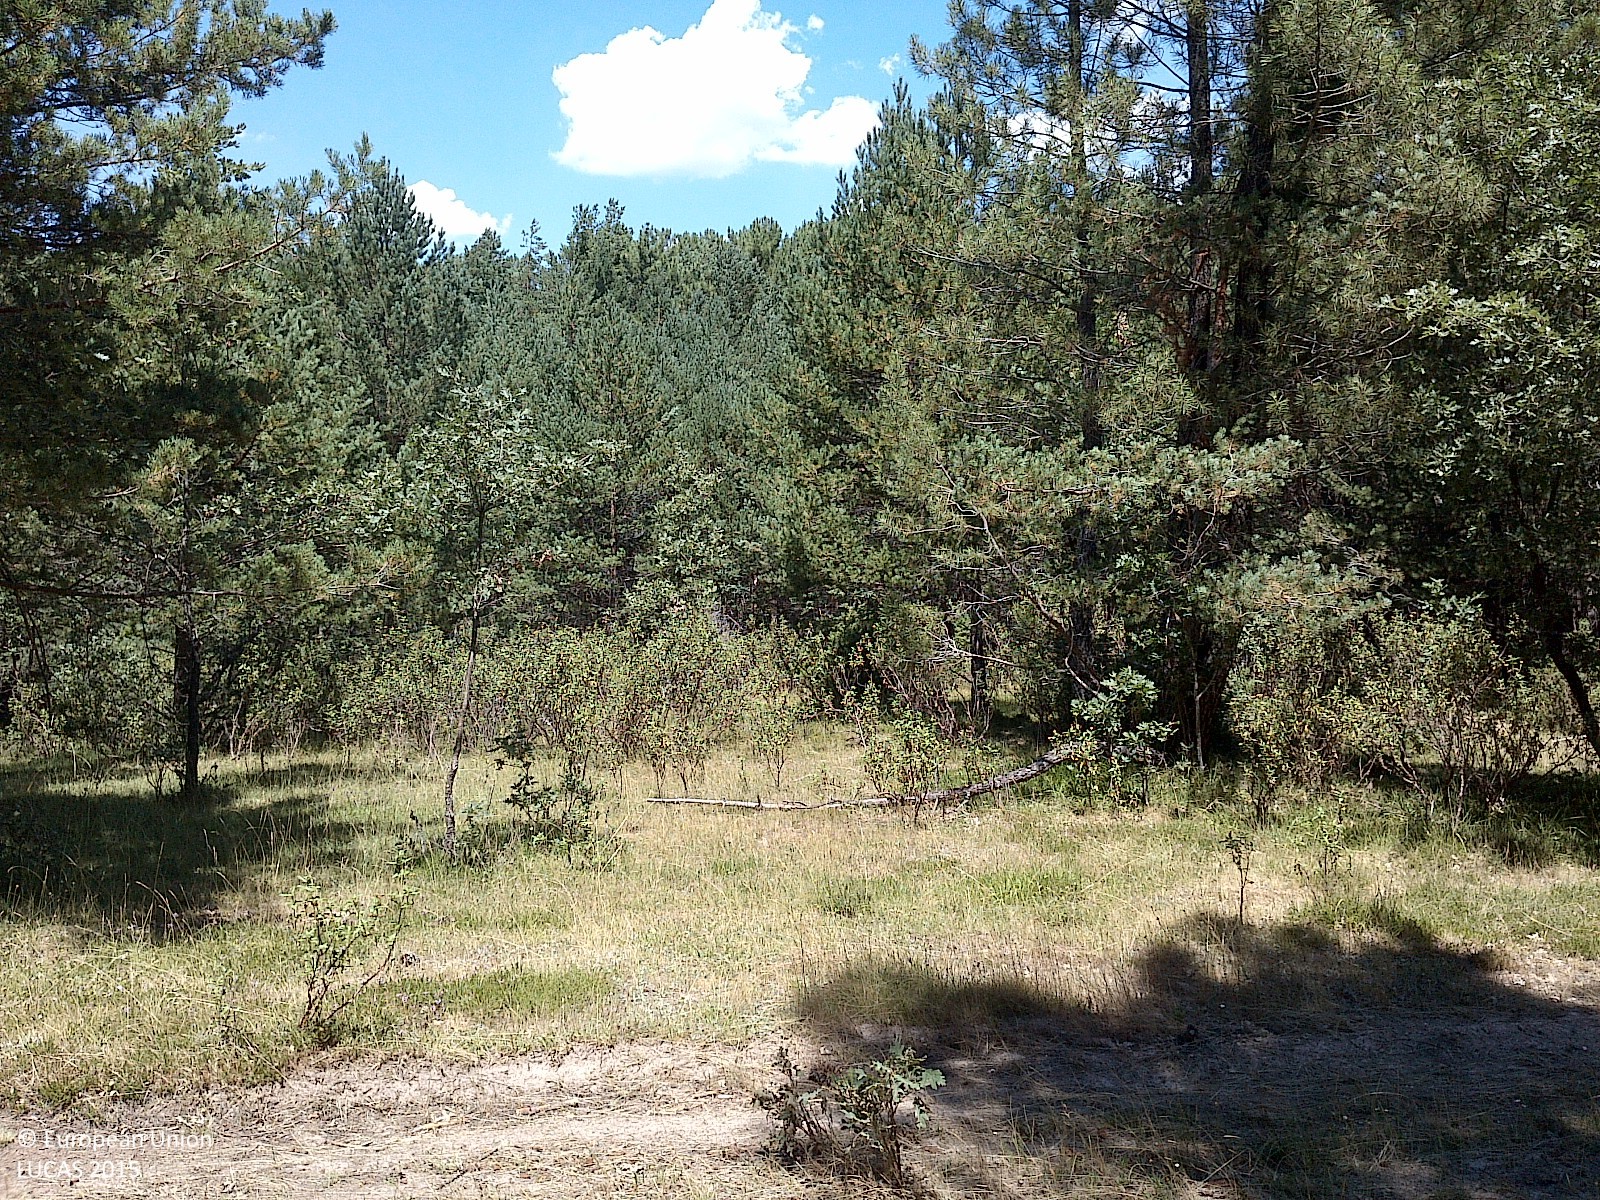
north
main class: Woodland
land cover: Pine dominated coniferous woodland
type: coniferous forest of the mediterranean region
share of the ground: > 75 %
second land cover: Grassland without tree/shrub cover
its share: 50 - 75 %
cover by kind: coniferous forest trees 80 %, herbaceous plants 15 %, shrubs 5 %
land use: Forestry
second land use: Agriculture (excluding fallow land and kitchen gardens)
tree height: > 5 m
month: July
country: ES
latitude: 41.8812
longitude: -3.1708
